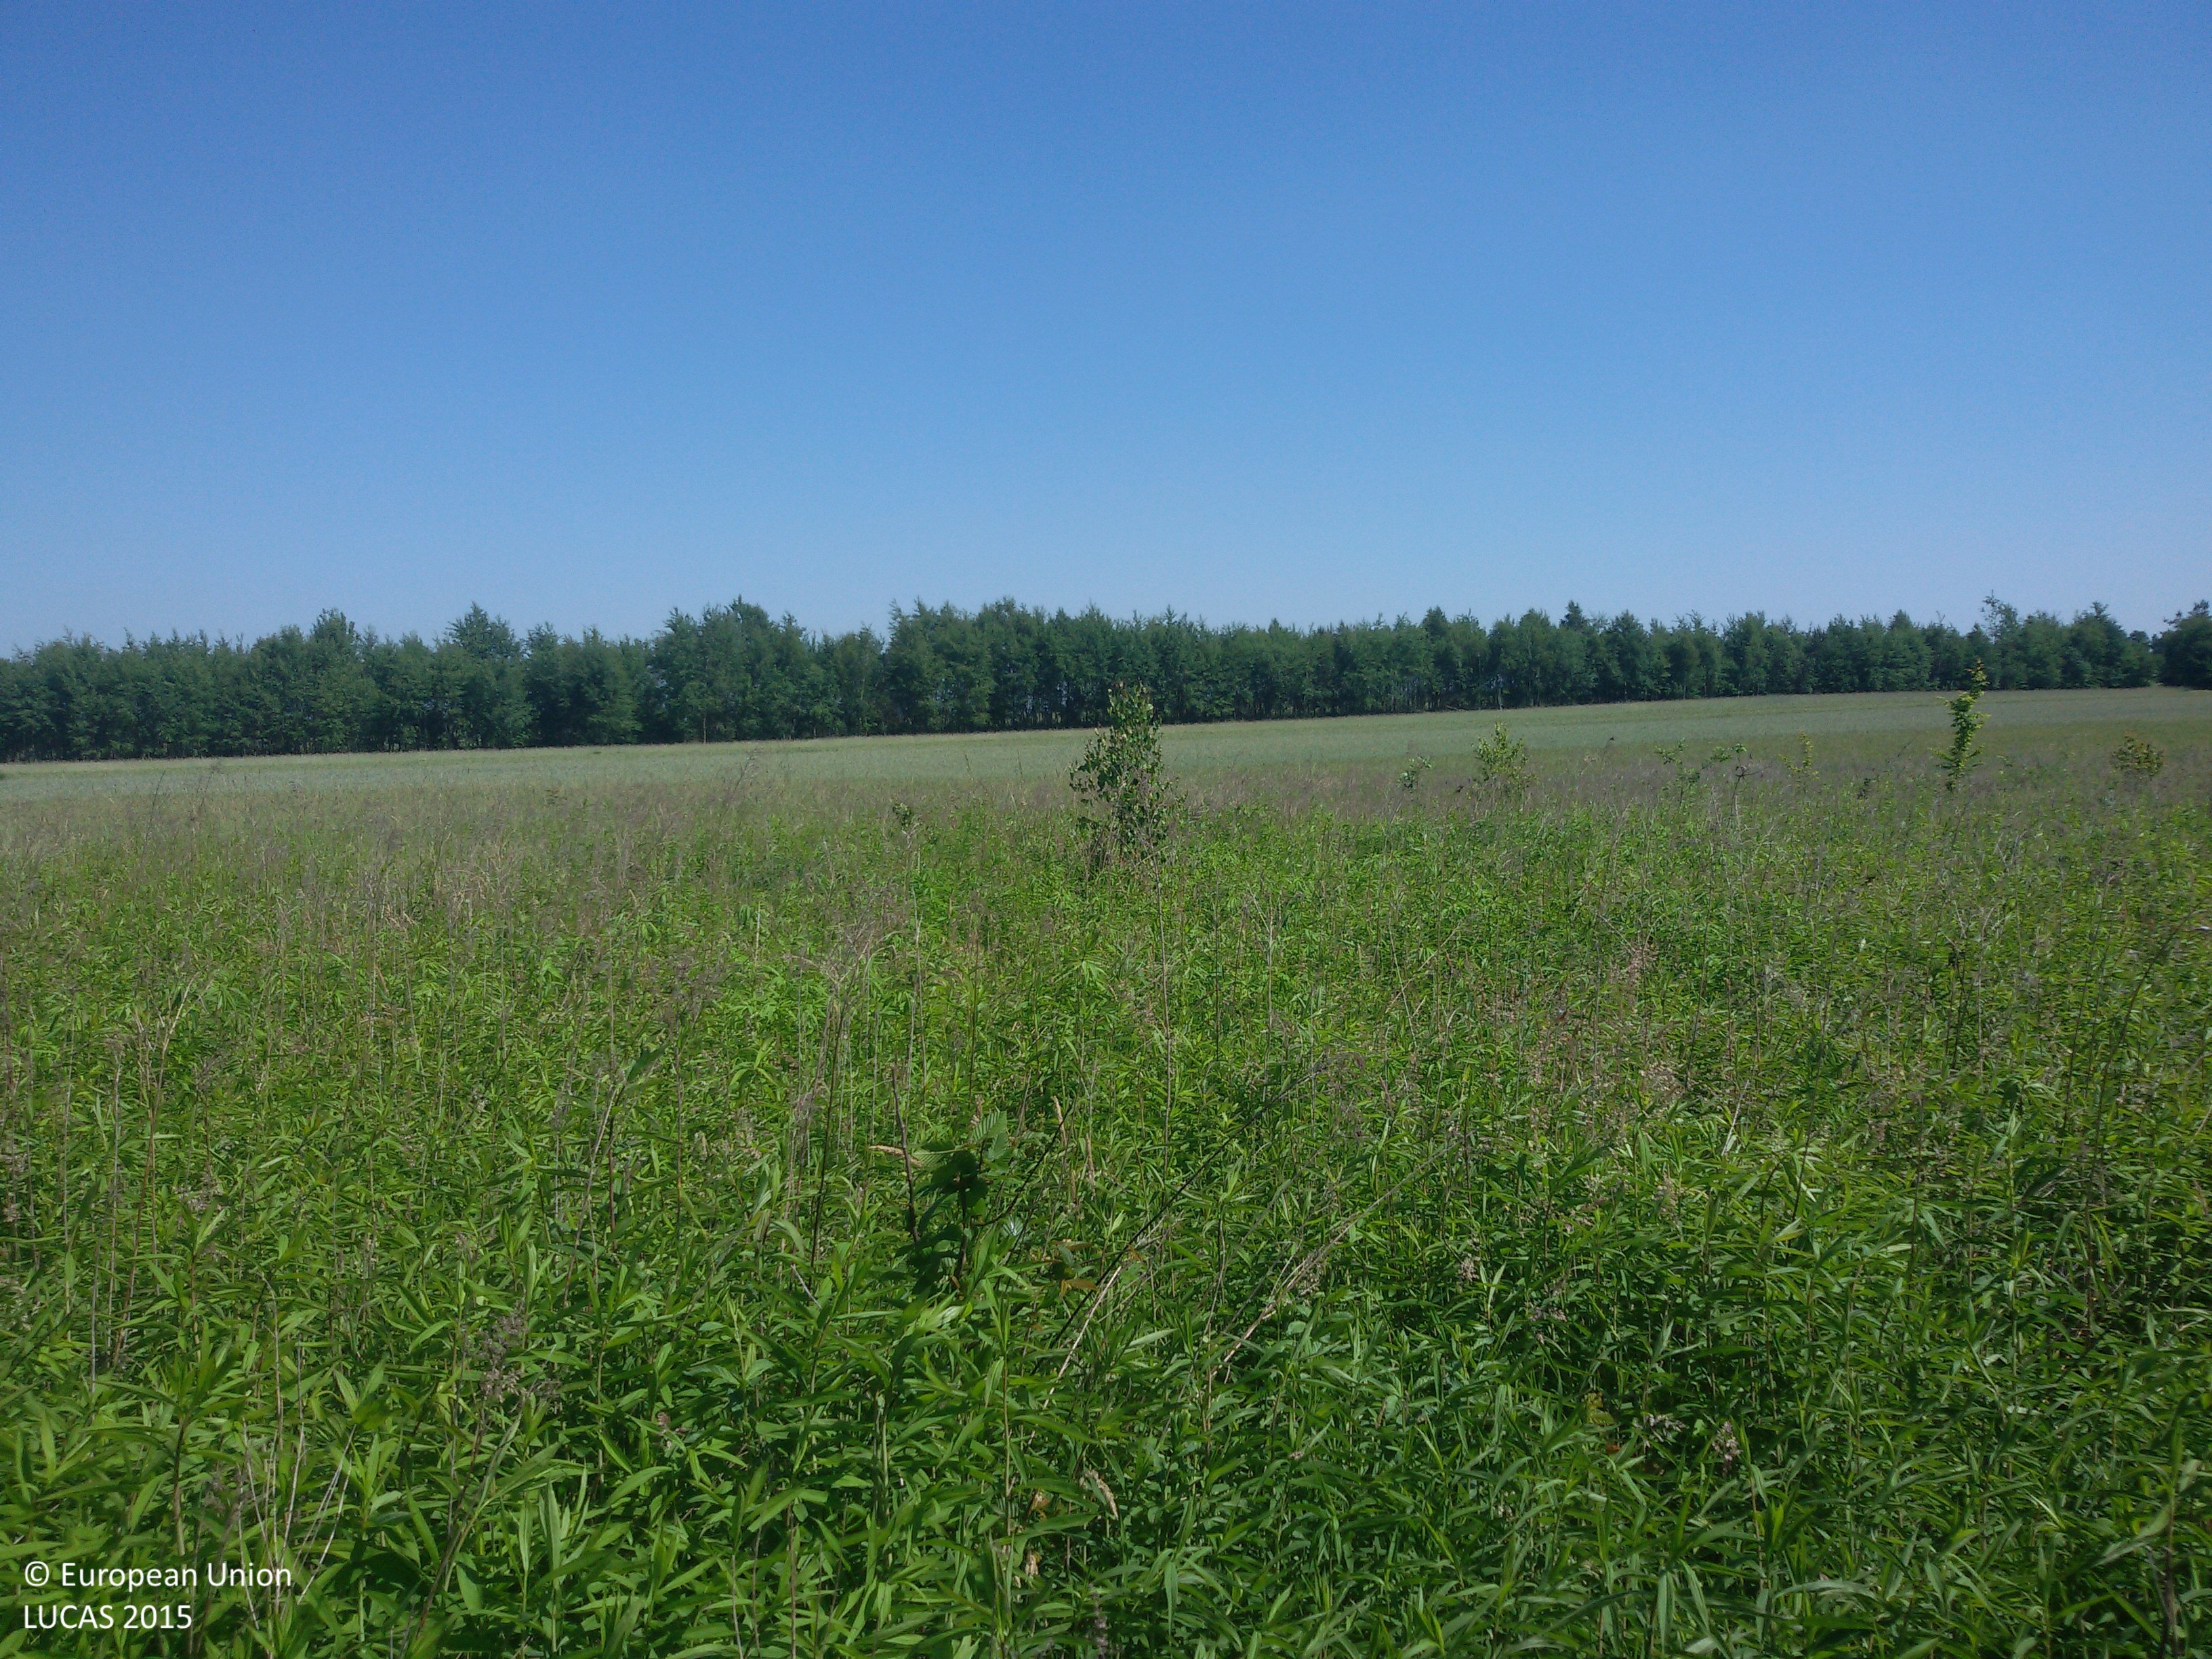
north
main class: Grassland
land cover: Grassland with sparse tree/shrub cover
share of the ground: > 75 %
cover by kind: herbaceous plants 90 %, broadleaved forest trees 5 %, shrubs 5 %
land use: Forestry
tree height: < 5 m
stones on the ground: < 10 %
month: June
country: PL
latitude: 51.4114
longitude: 22.7664
